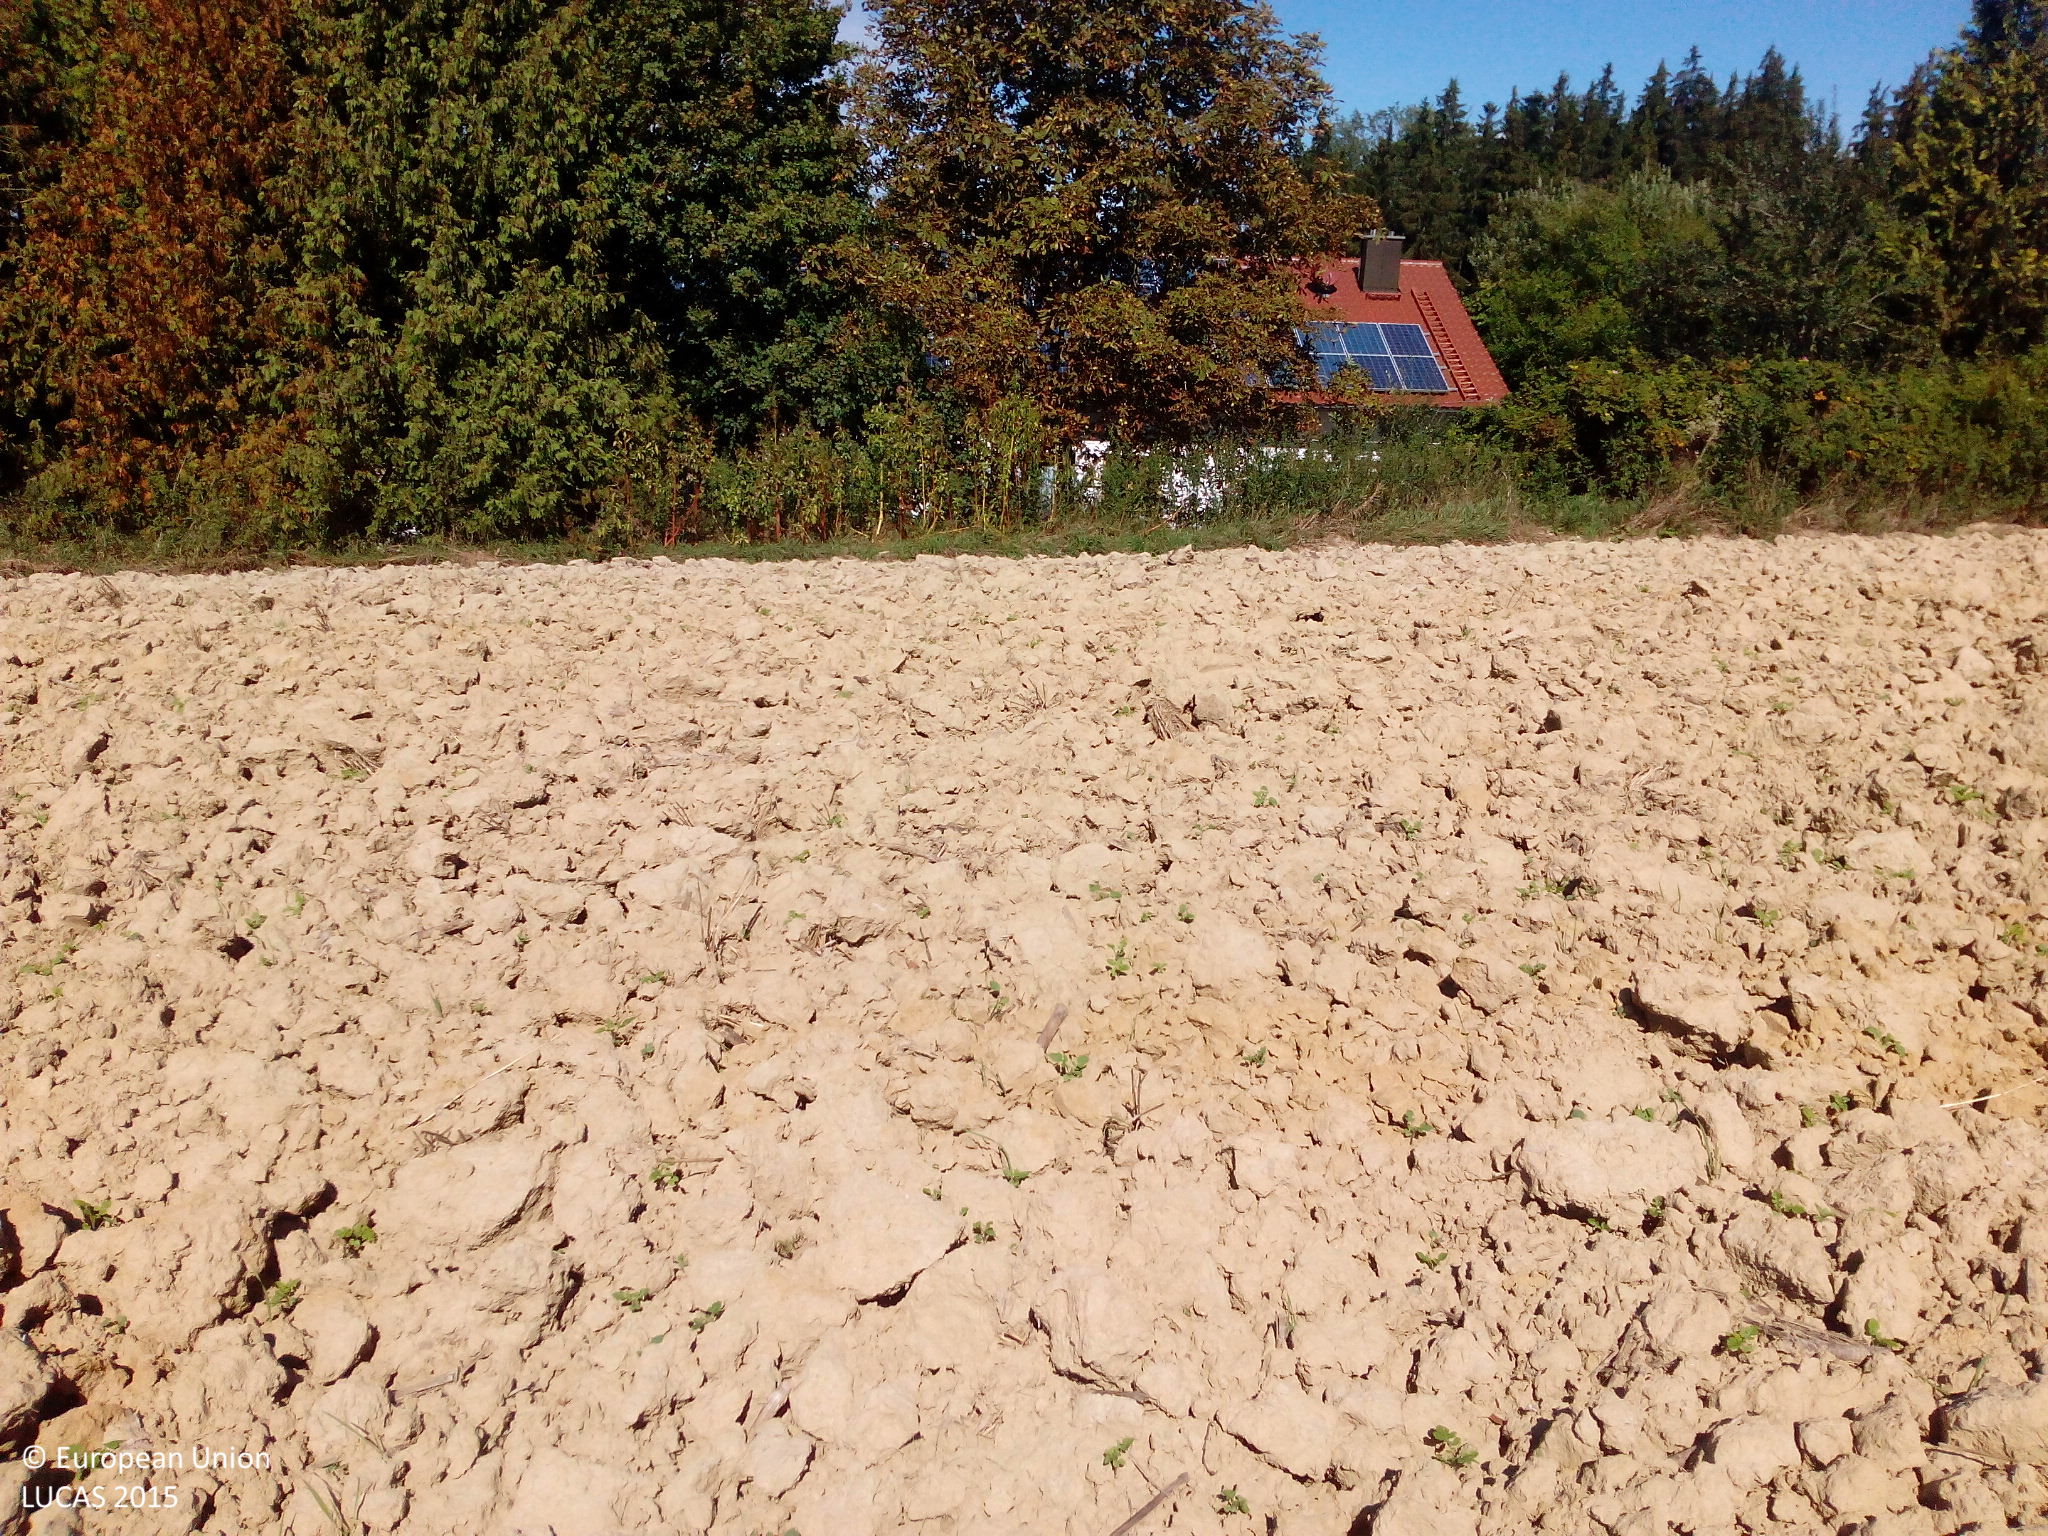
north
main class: Cropland
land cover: Rape and turnip rape
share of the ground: < 10 %
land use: Agriculture (excluding fallow land and kitchen gardens)
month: September
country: DE
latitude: 48.4202
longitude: 12.0665
